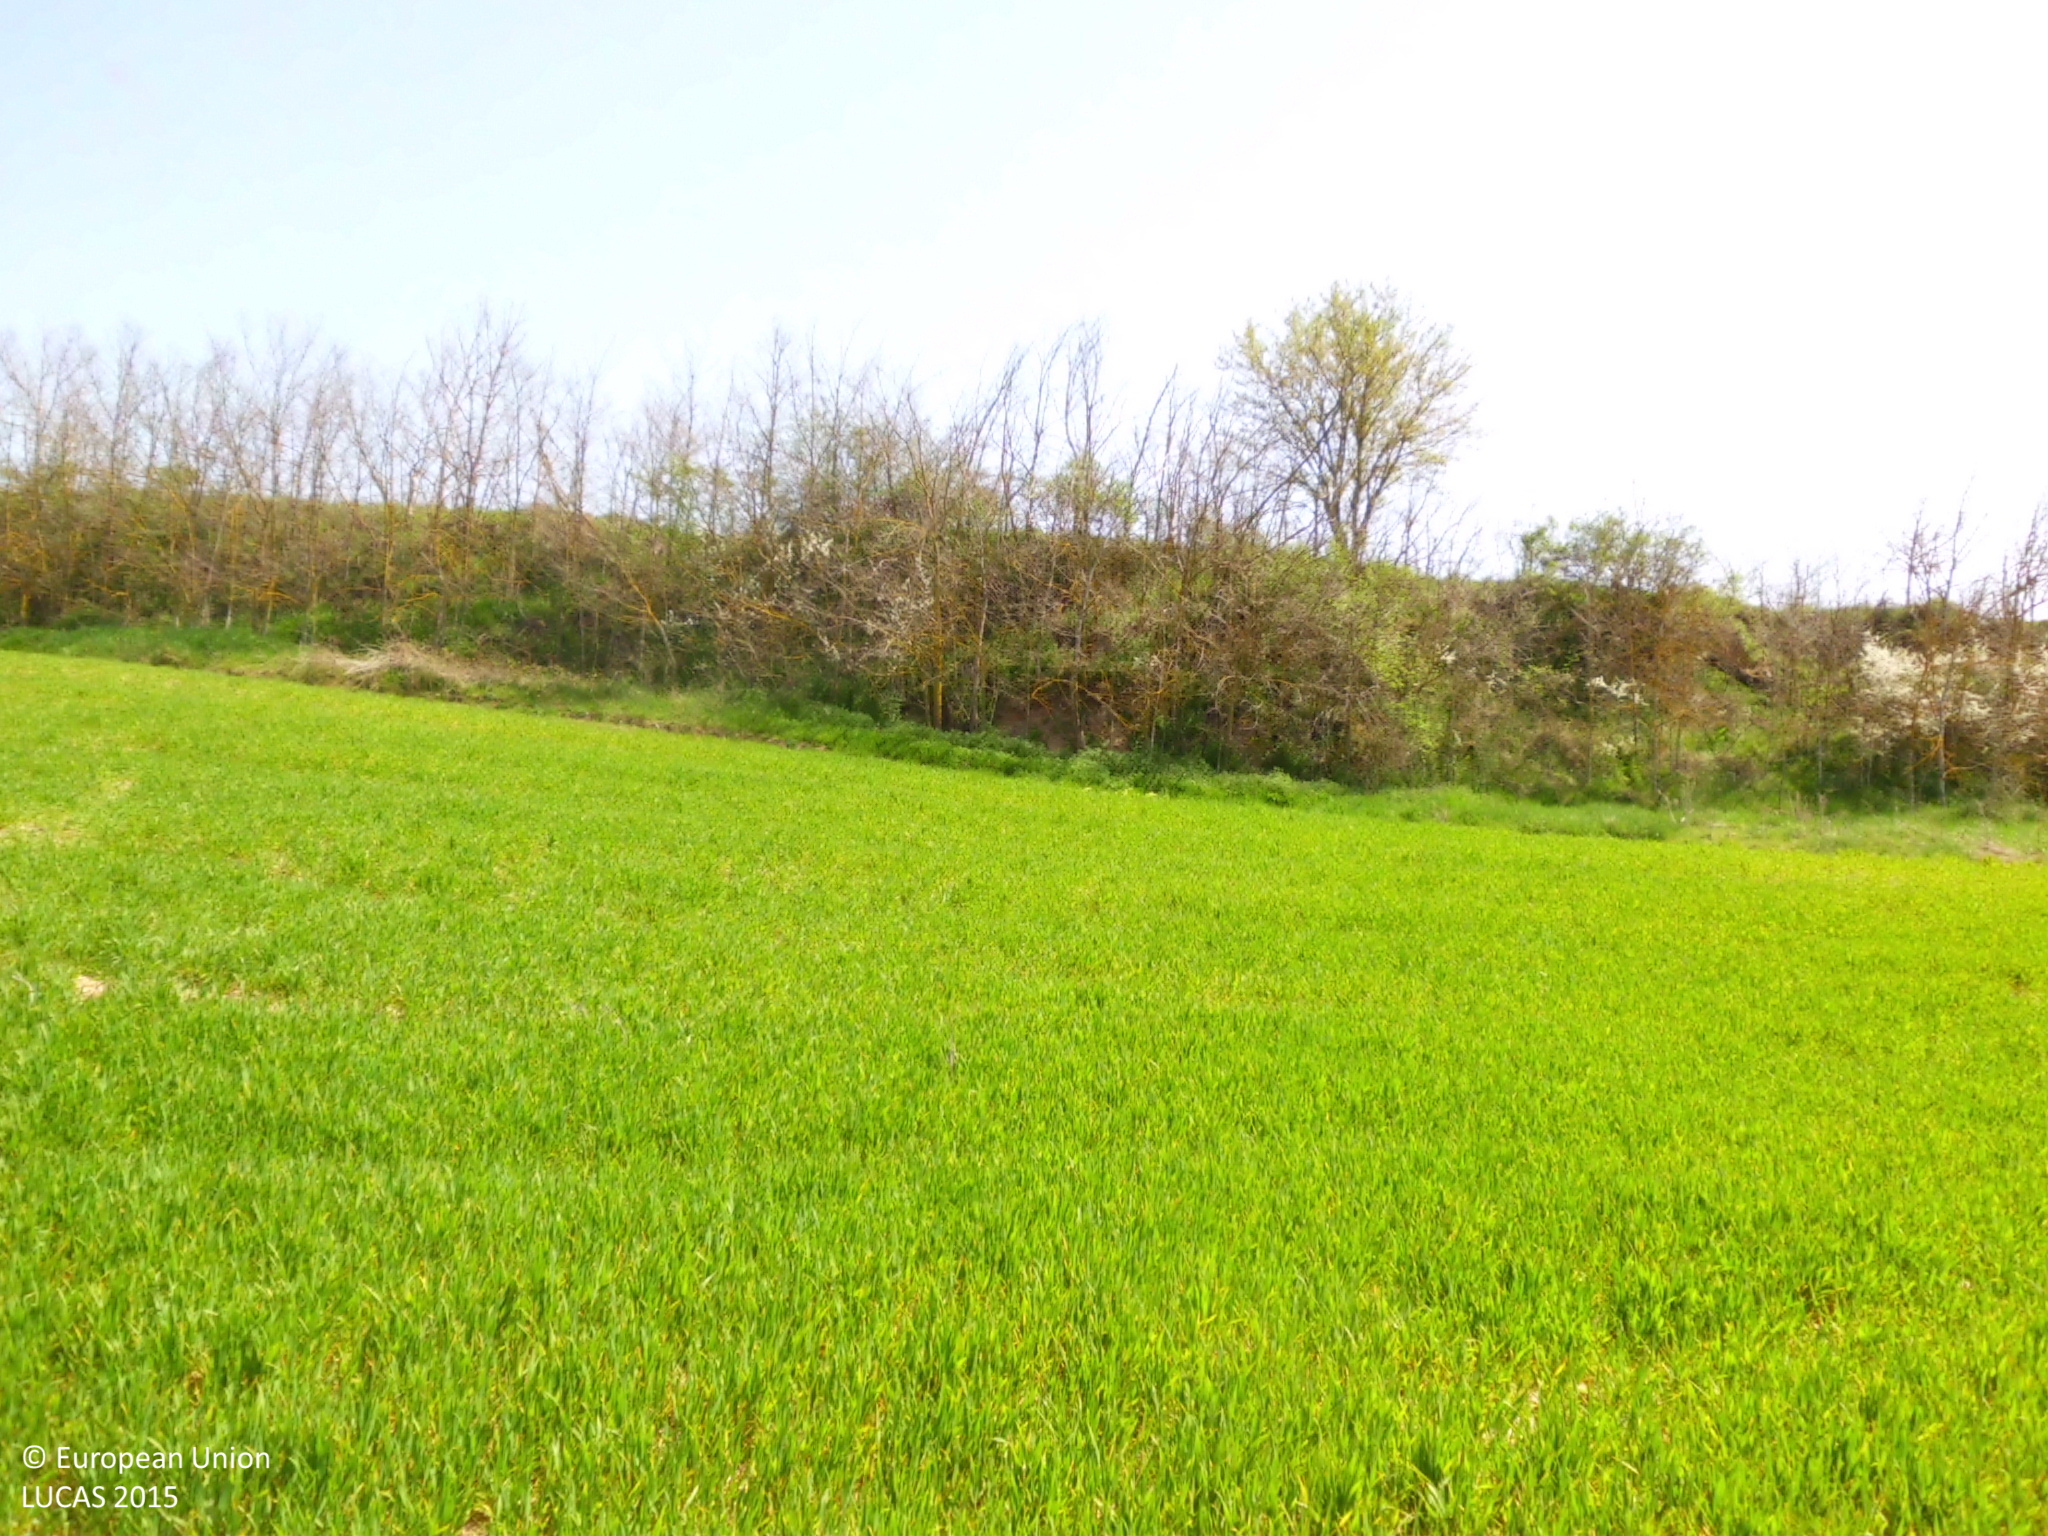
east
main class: Cropland
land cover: Barley
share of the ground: 50 - 75 %
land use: Agriculture (excluding fallow land and kitchen gardens)
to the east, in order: Barley; Grass margins; Groves; Common wheat; Grassland without tree/shrub cover; Tracks; Grassland without tree/shrub cover; Other bare soil
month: April
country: ES
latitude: 42.5735
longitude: -3.3245
